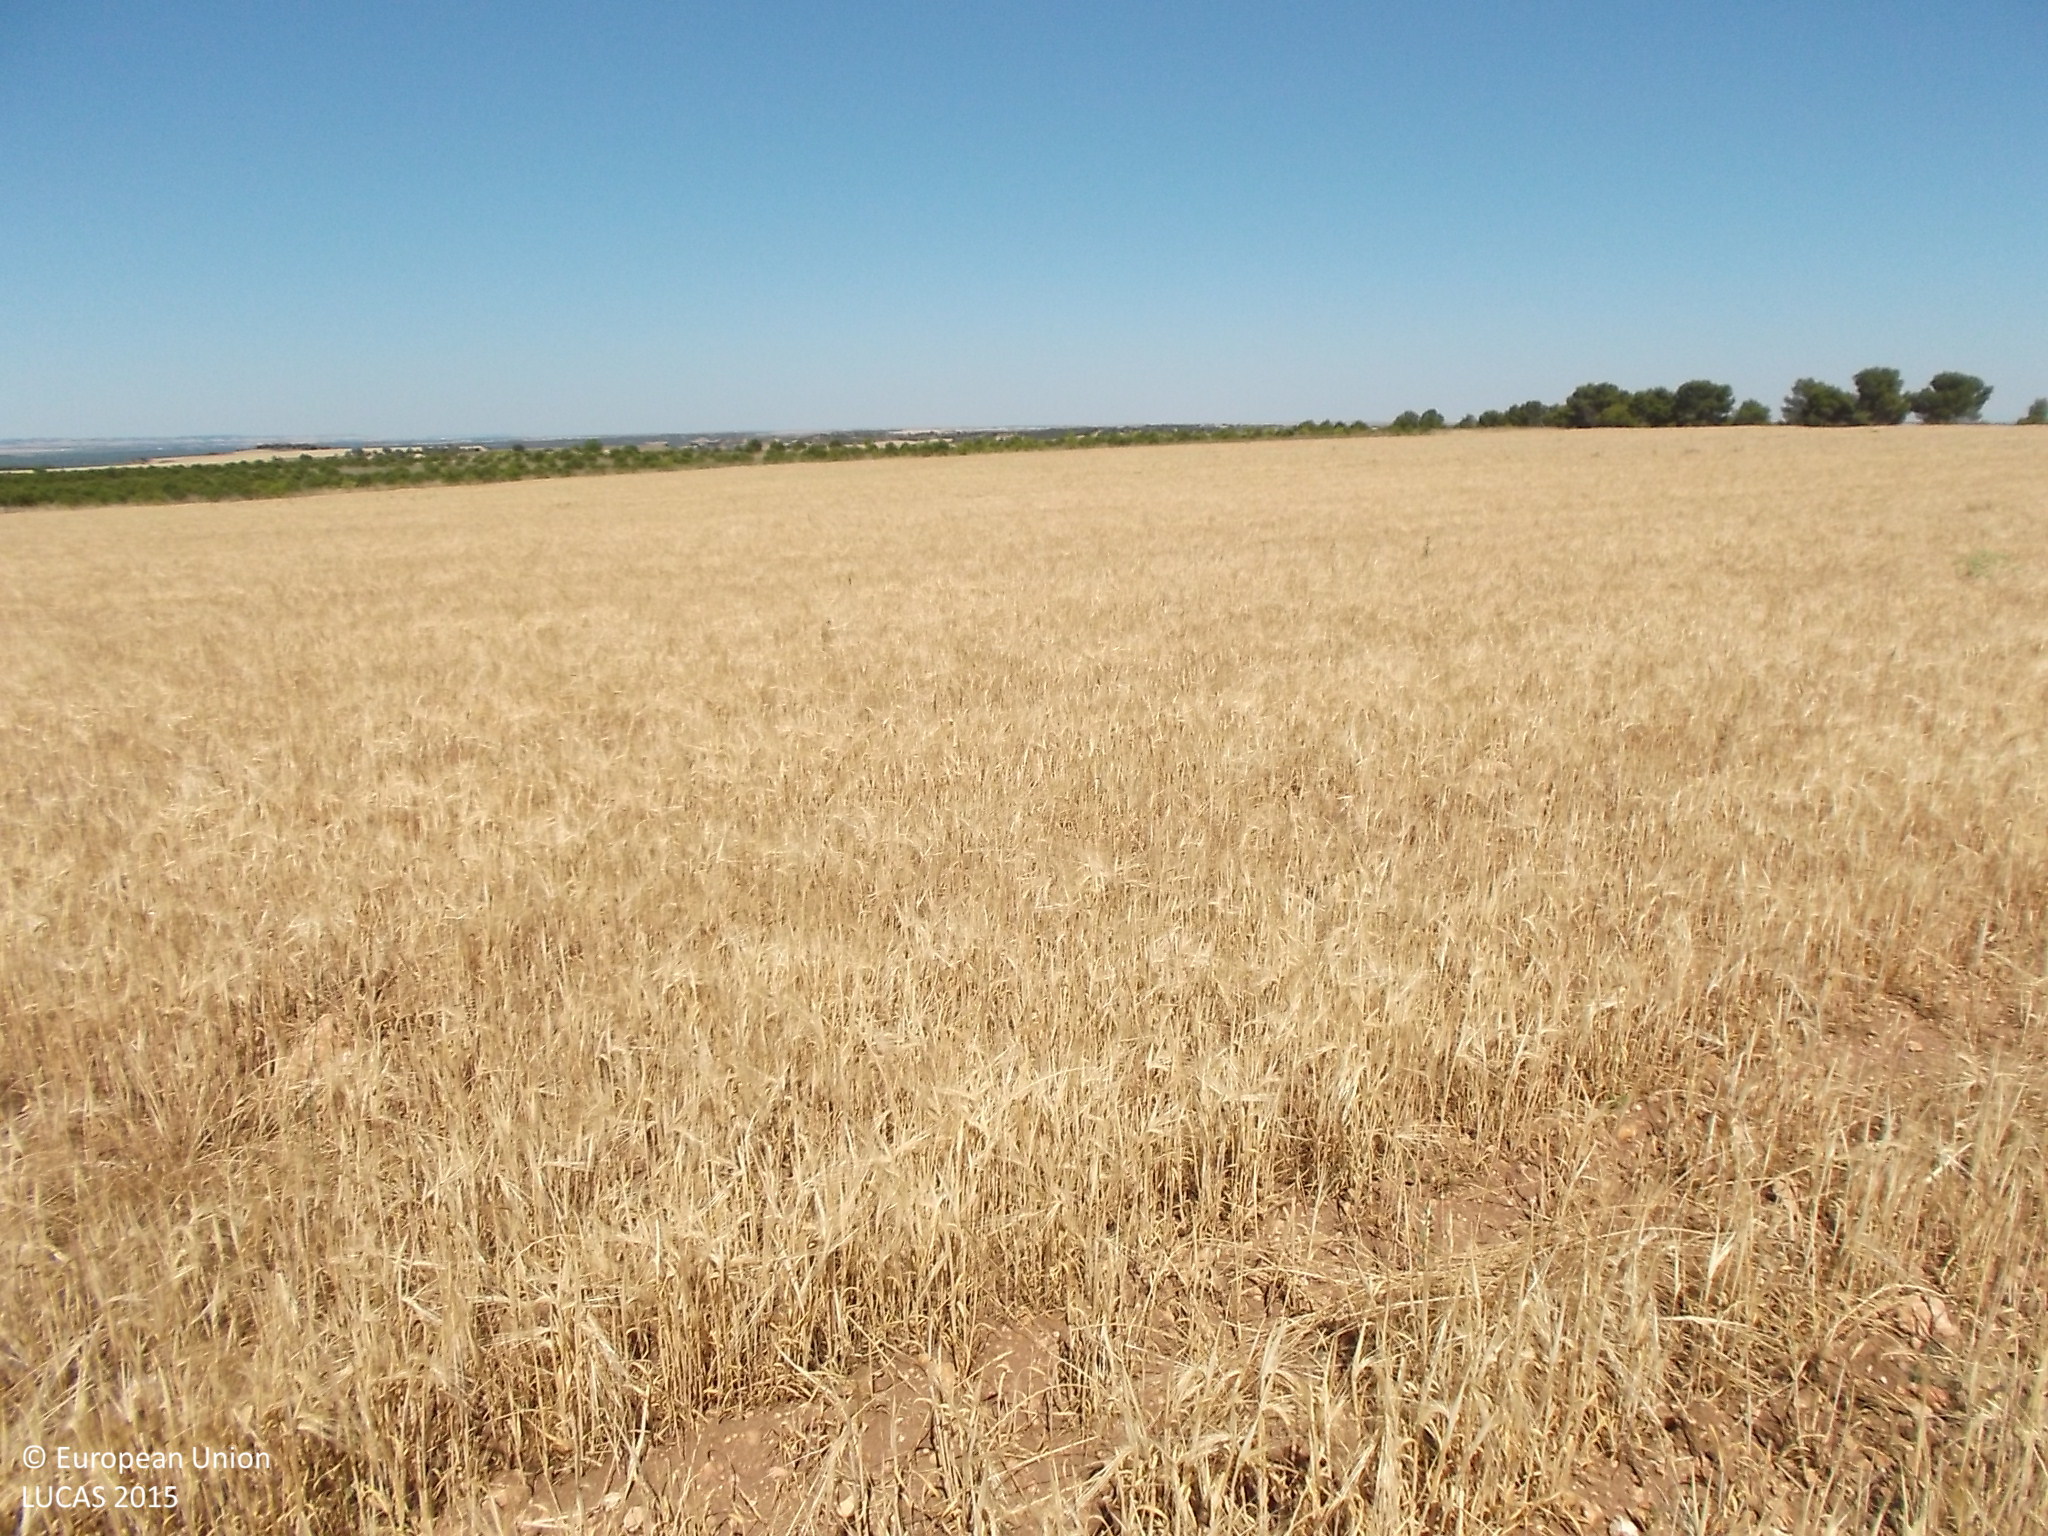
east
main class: Cropland
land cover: Barley
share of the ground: > 75 %
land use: Agriculture (excluding fallow land and kitchen gardens)
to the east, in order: Barley; Pine dominated coniferous woodland
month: June
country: ES
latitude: 41.3705
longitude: -5.3197
